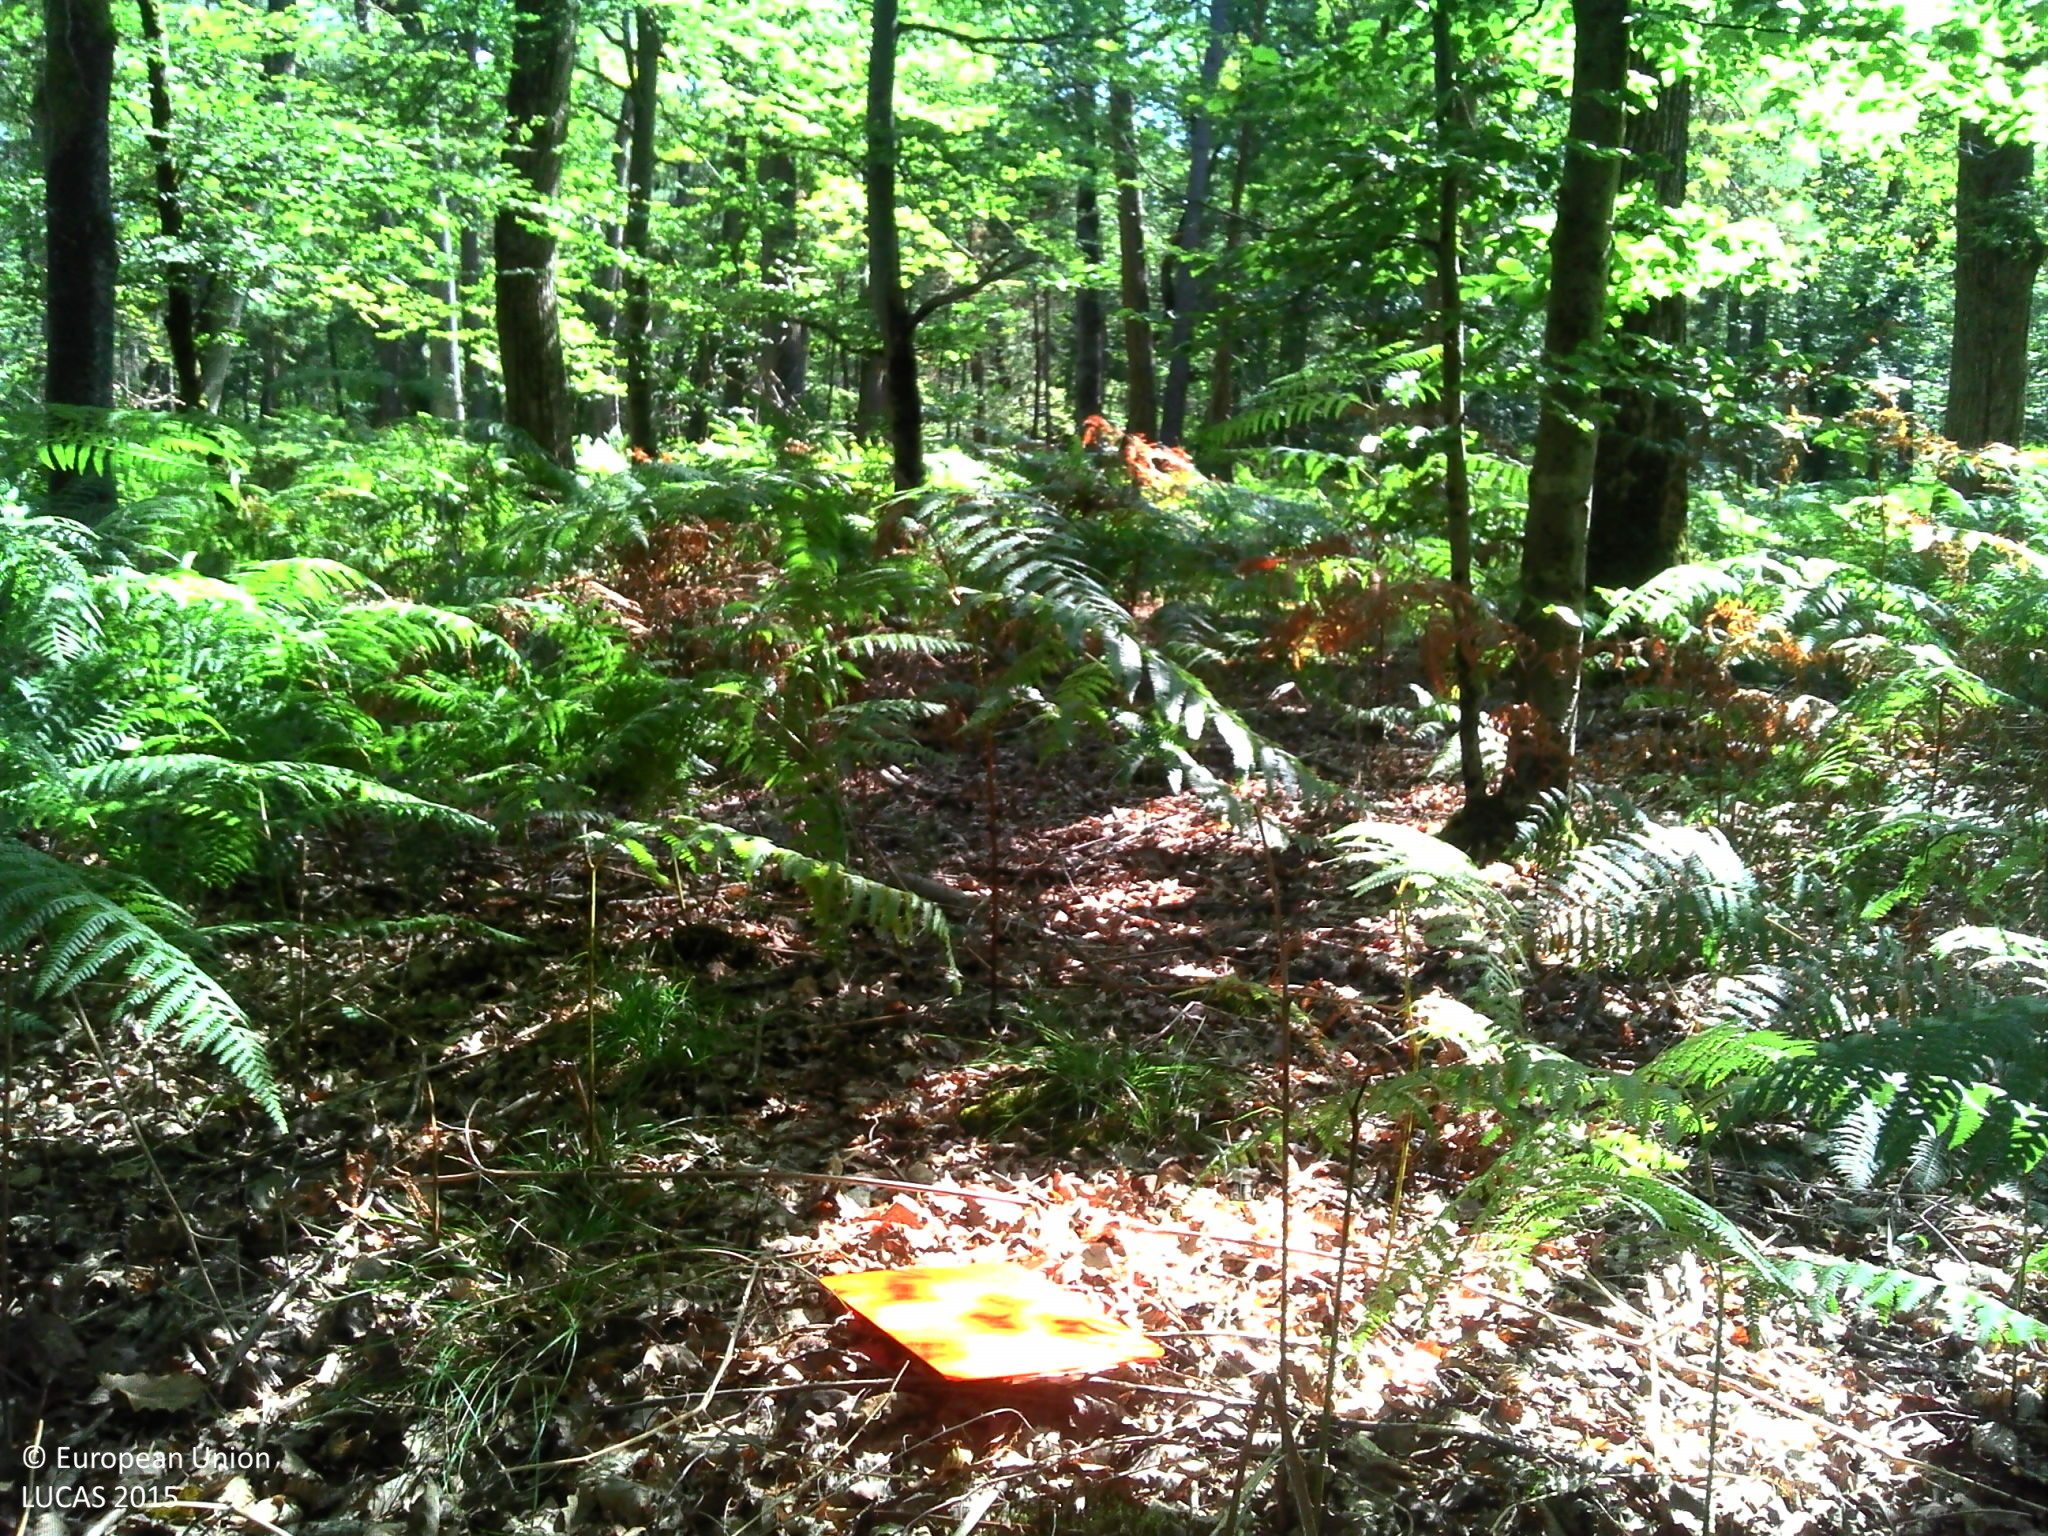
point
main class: Woodland
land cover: Broadleaved woodland
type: beech forest
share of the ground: > 75 %
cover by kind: broadleaved forest trees 75 %, herbaceous plants 10 %, lichens and mosses 10 %, coniferous forest trees 5 %
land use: Forestry
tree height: > 5 m
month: September
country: FR
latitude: 48.3832
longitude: 2.7670
